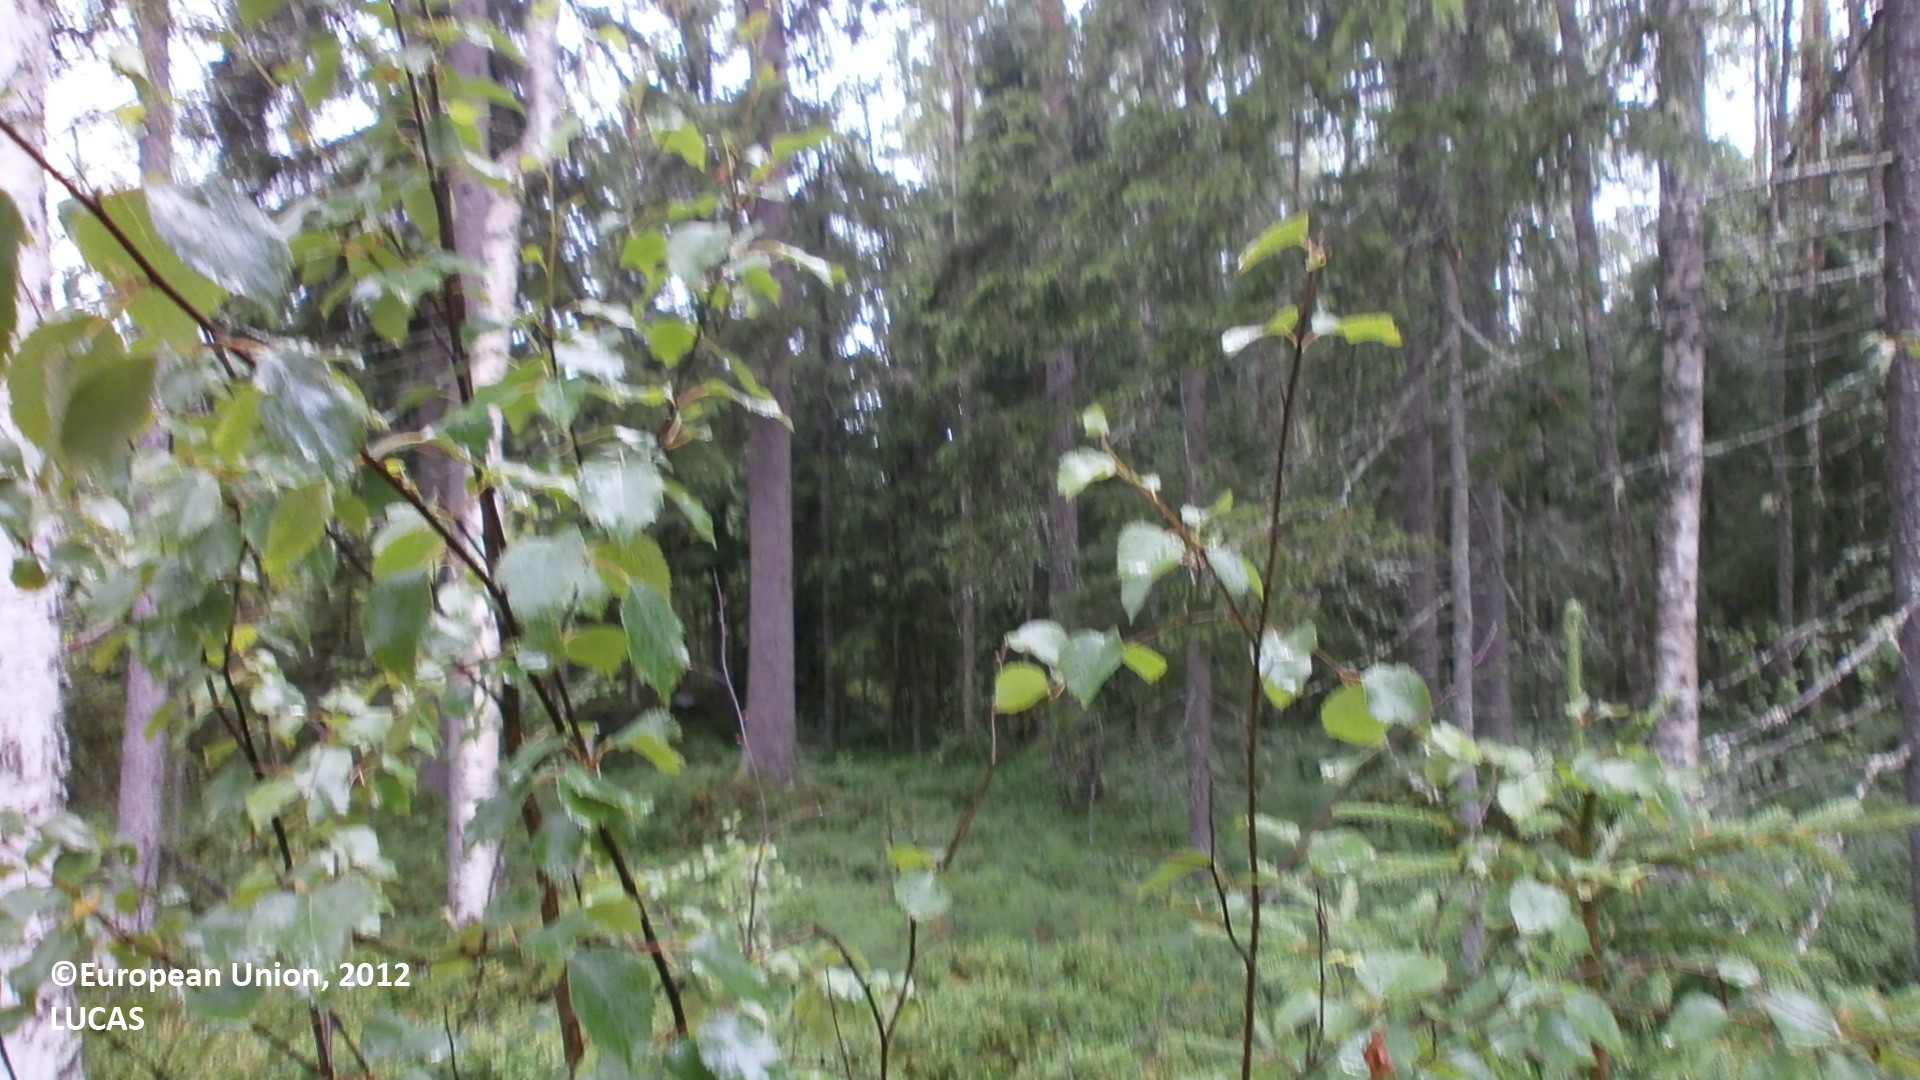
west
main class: Woodland
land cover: Spruce dominated mixed woodland
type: boreal forest
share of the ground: > 75 %
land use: Forestry
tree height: > 5 m
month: July
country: FI
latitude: 64.0522
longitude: 23.7646
